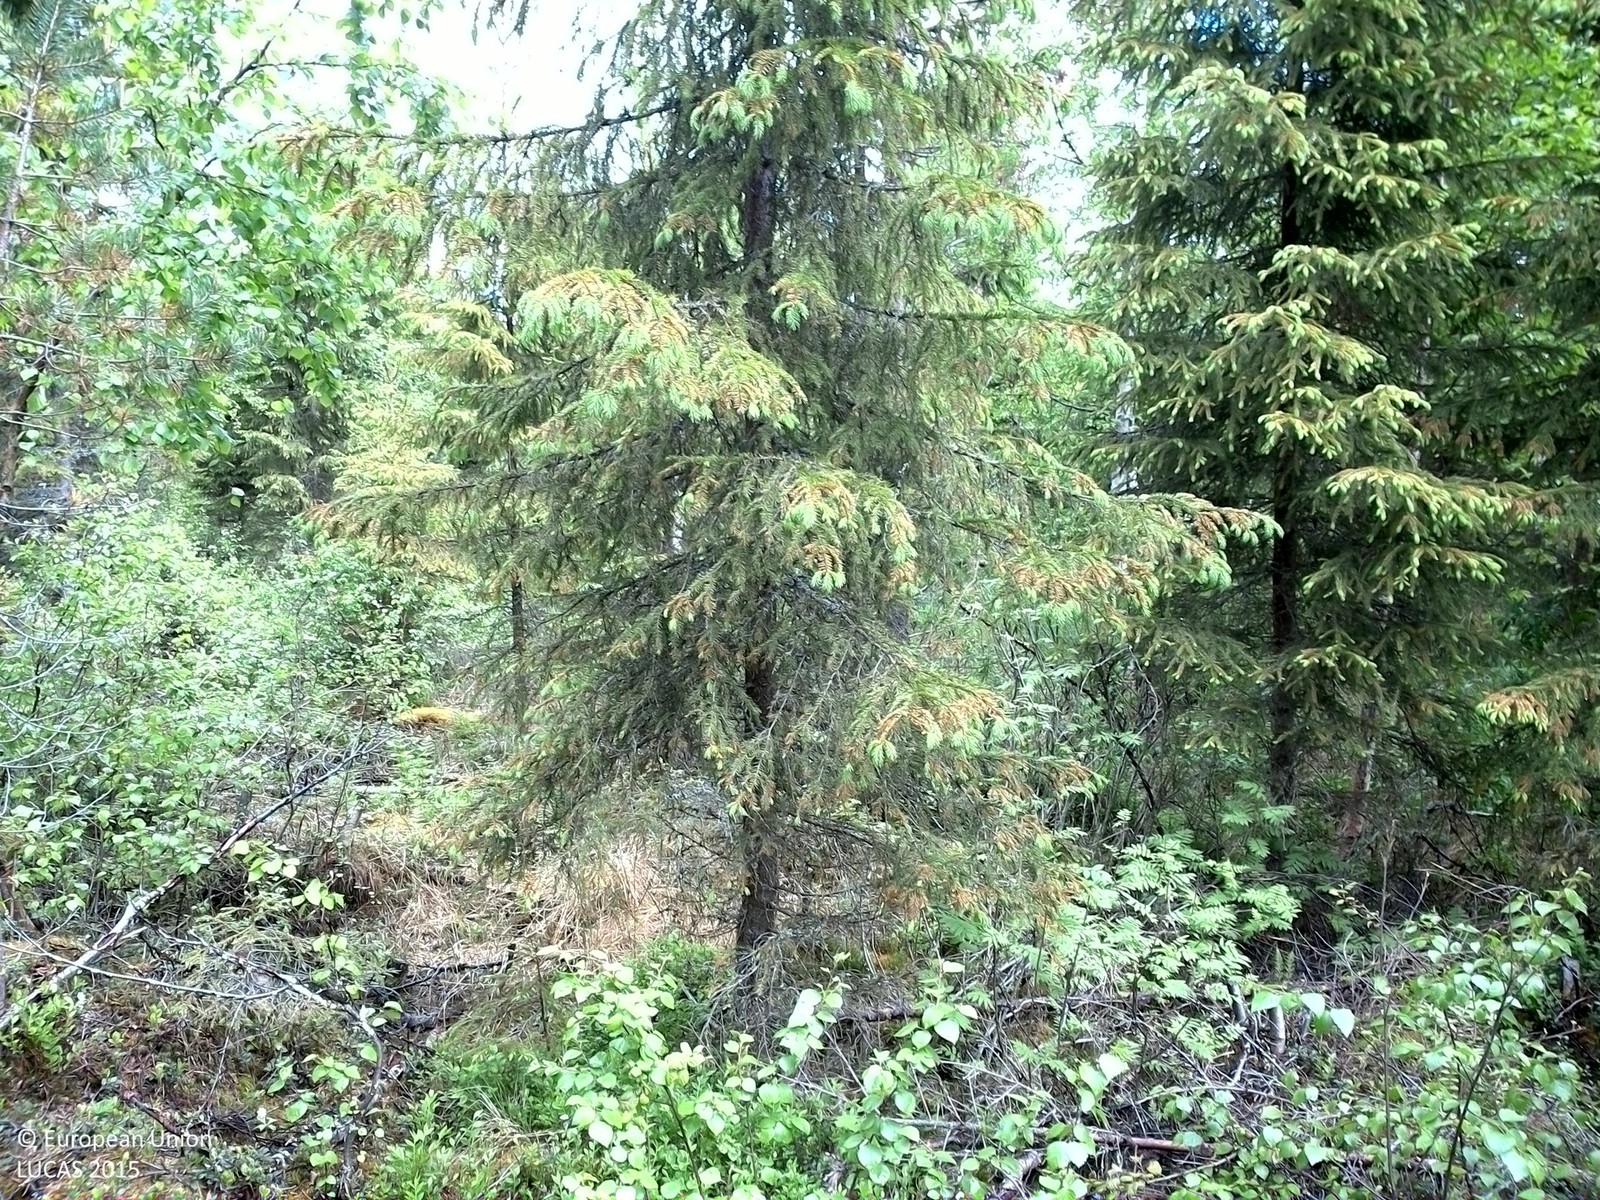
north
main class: Woodland
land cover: Spruce dominated mixed woodland
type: boreal forest
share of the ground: 50 - 75 %
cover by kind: coniferous forest trees 40 %, shrubs 30 %, broadleaved forest trees 20 %, herbaceous plants 10 %
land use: Forestry
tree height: < 5 m
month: June
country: SE
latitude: 63.5046
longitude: 18.0313
